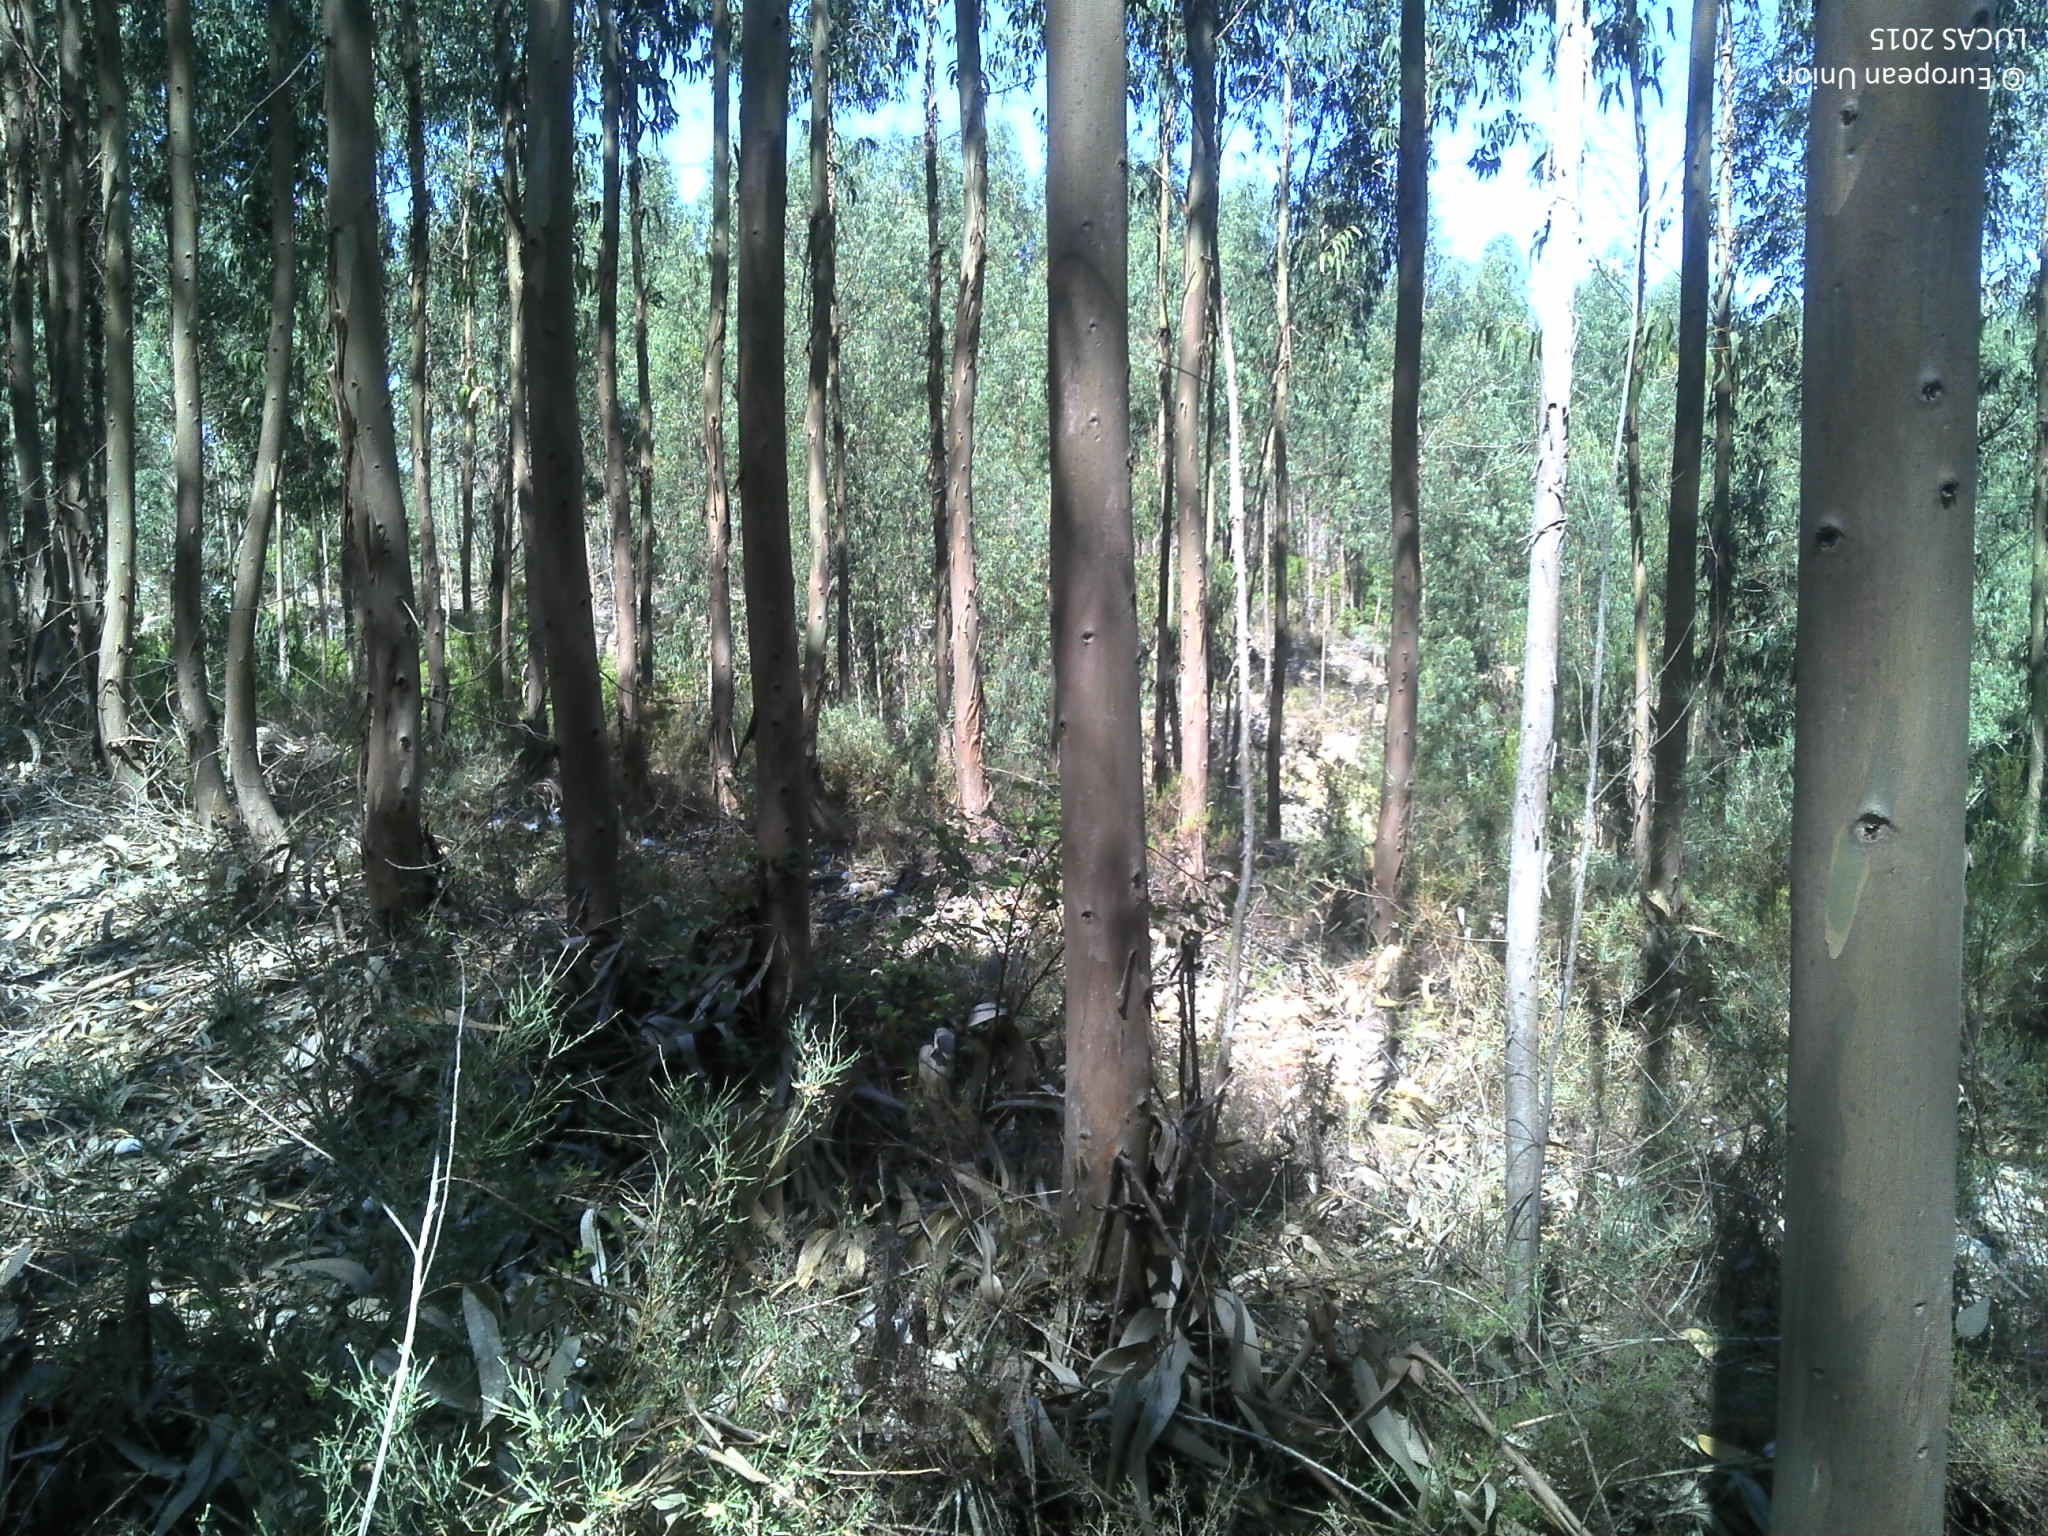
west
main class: Woodland
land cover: Broadleaved woodland
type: exotic forest
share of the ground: 50 - 75 %
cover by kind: broadleaved forest trees 75 %, unconsolidated bare surface 15 %, shrubs 10 %
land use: Forestry
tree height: > 5 m
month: June
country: PT
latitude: 39.3141
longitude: -8.3553
